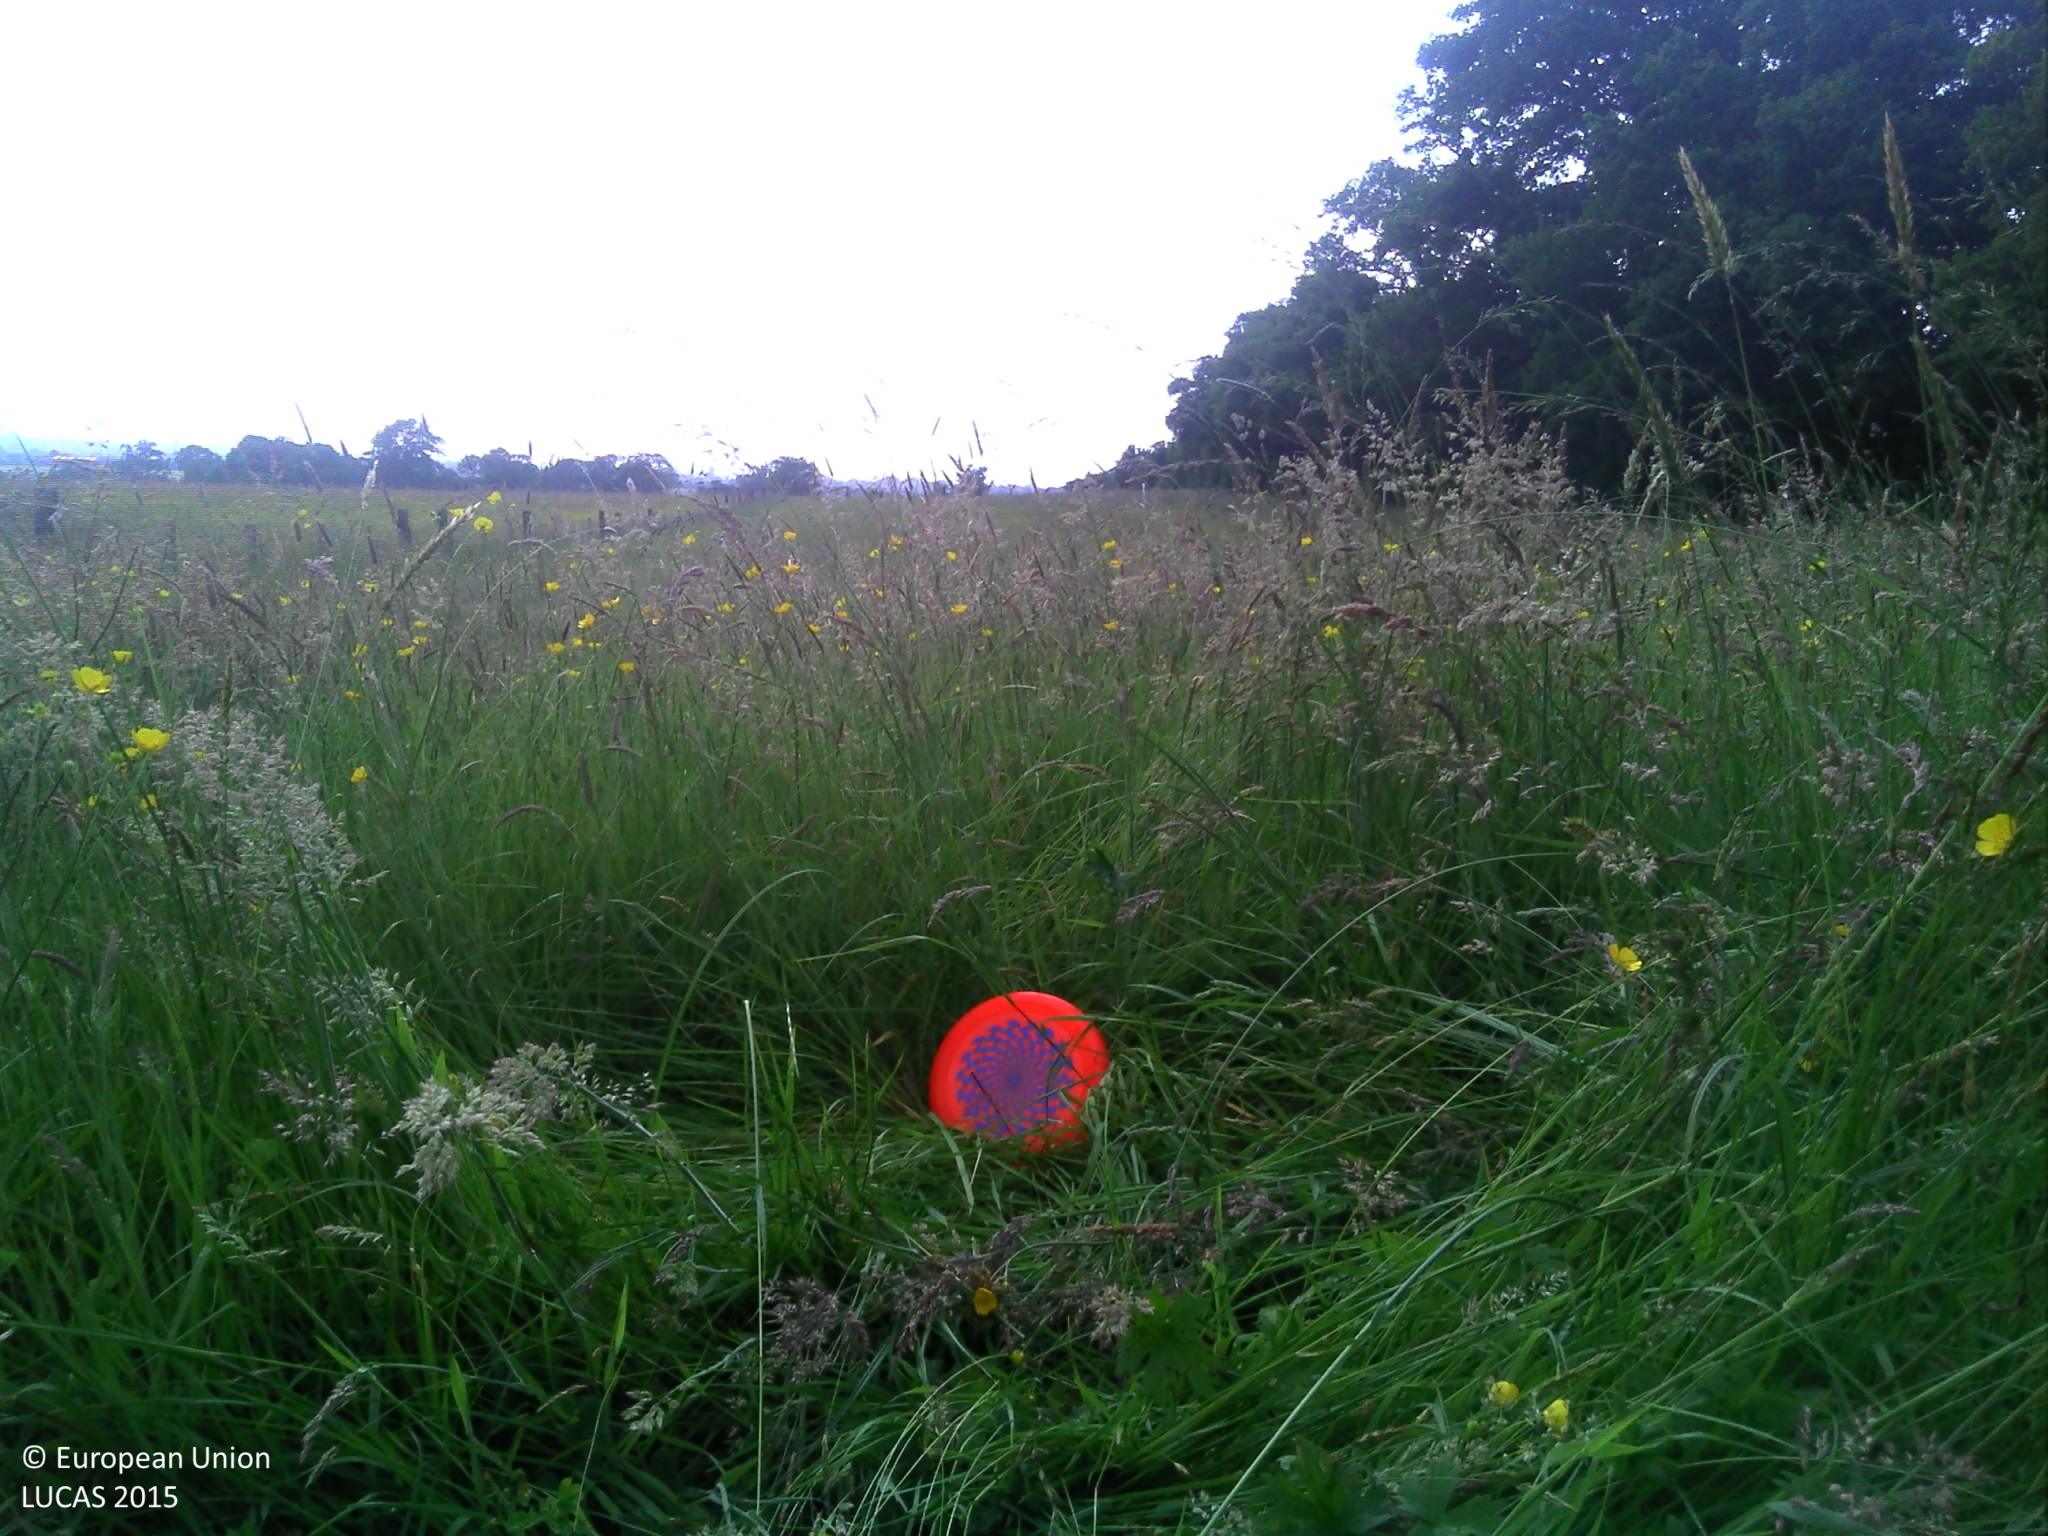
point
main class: Grassland
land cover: Grassland without tree/shrub cover
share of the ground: > 75 %
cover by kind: herbaceous plants 95 %
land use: Agriculture (excluding fallow land and kitchen gardens)
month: June
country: FR
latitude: 48.7055
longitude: 0.1467
